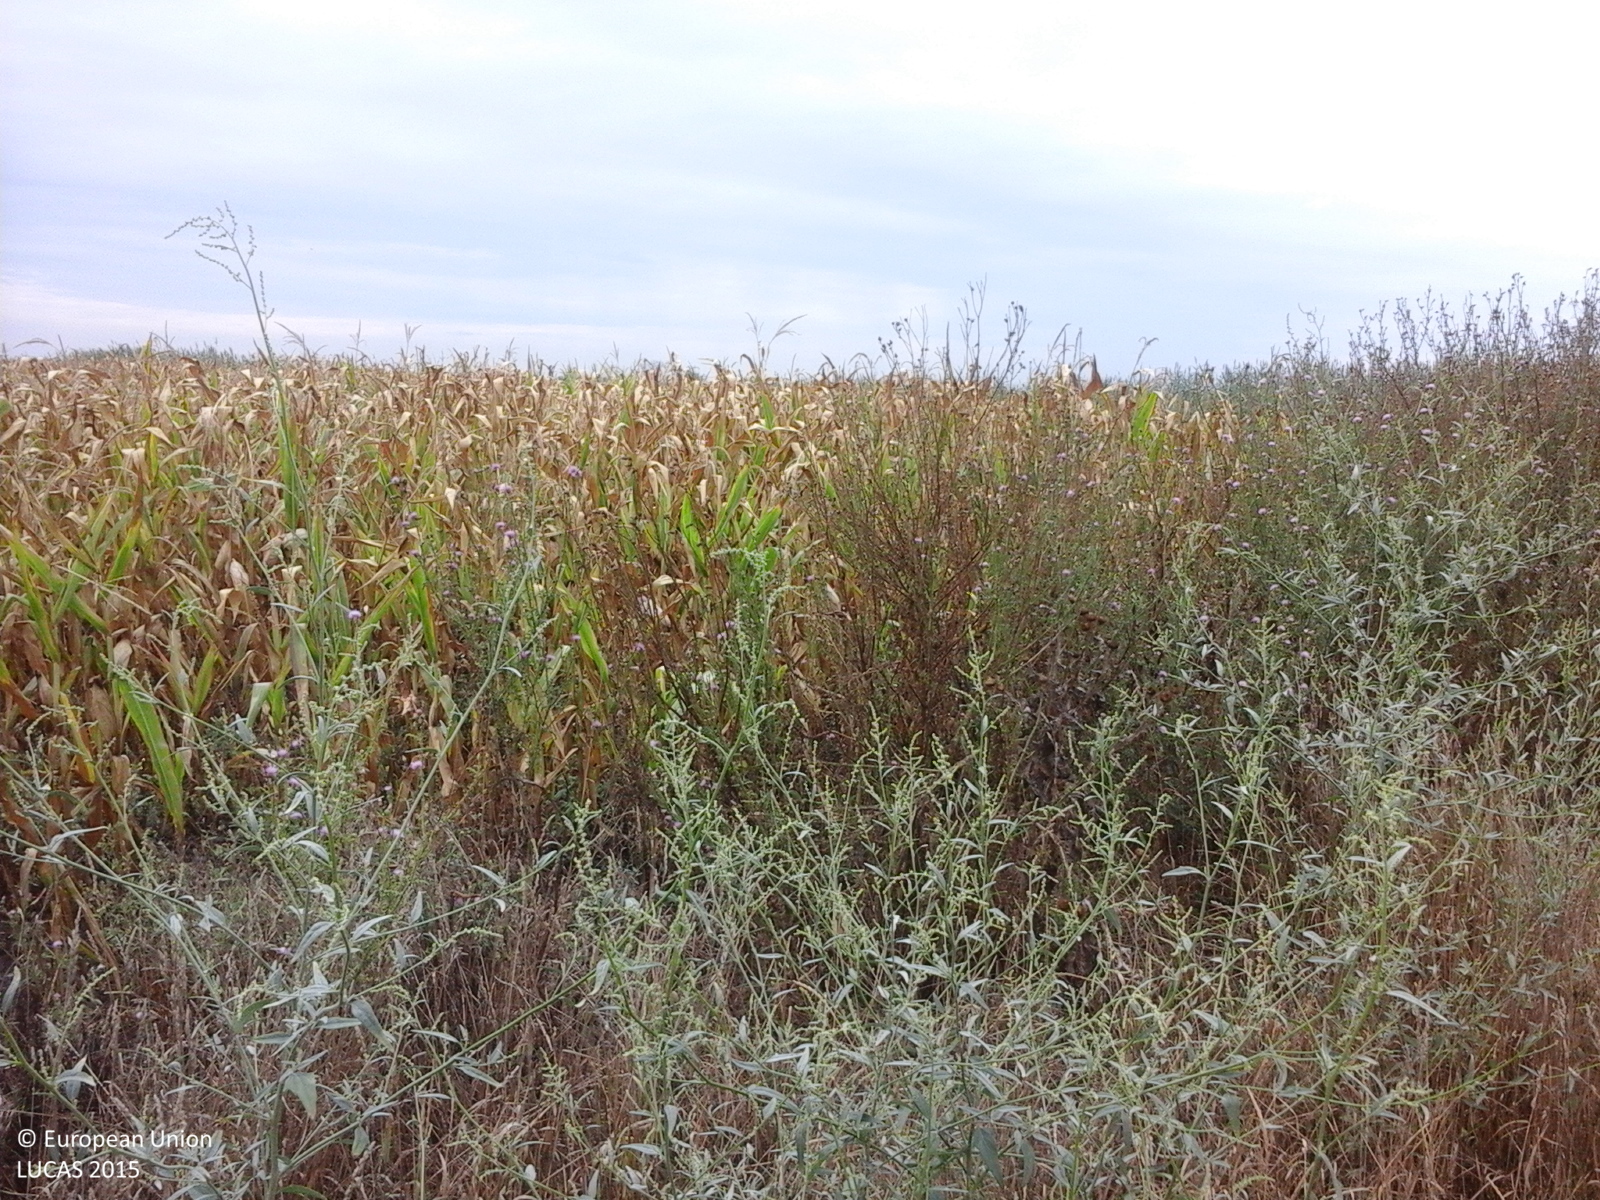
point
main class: Cropland
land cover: Maize
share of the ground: > 75 %
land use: Agriculture (excluding fallow land and kitchen gardens)
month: August
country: RO
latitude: 45.7854
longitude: 20.7921
